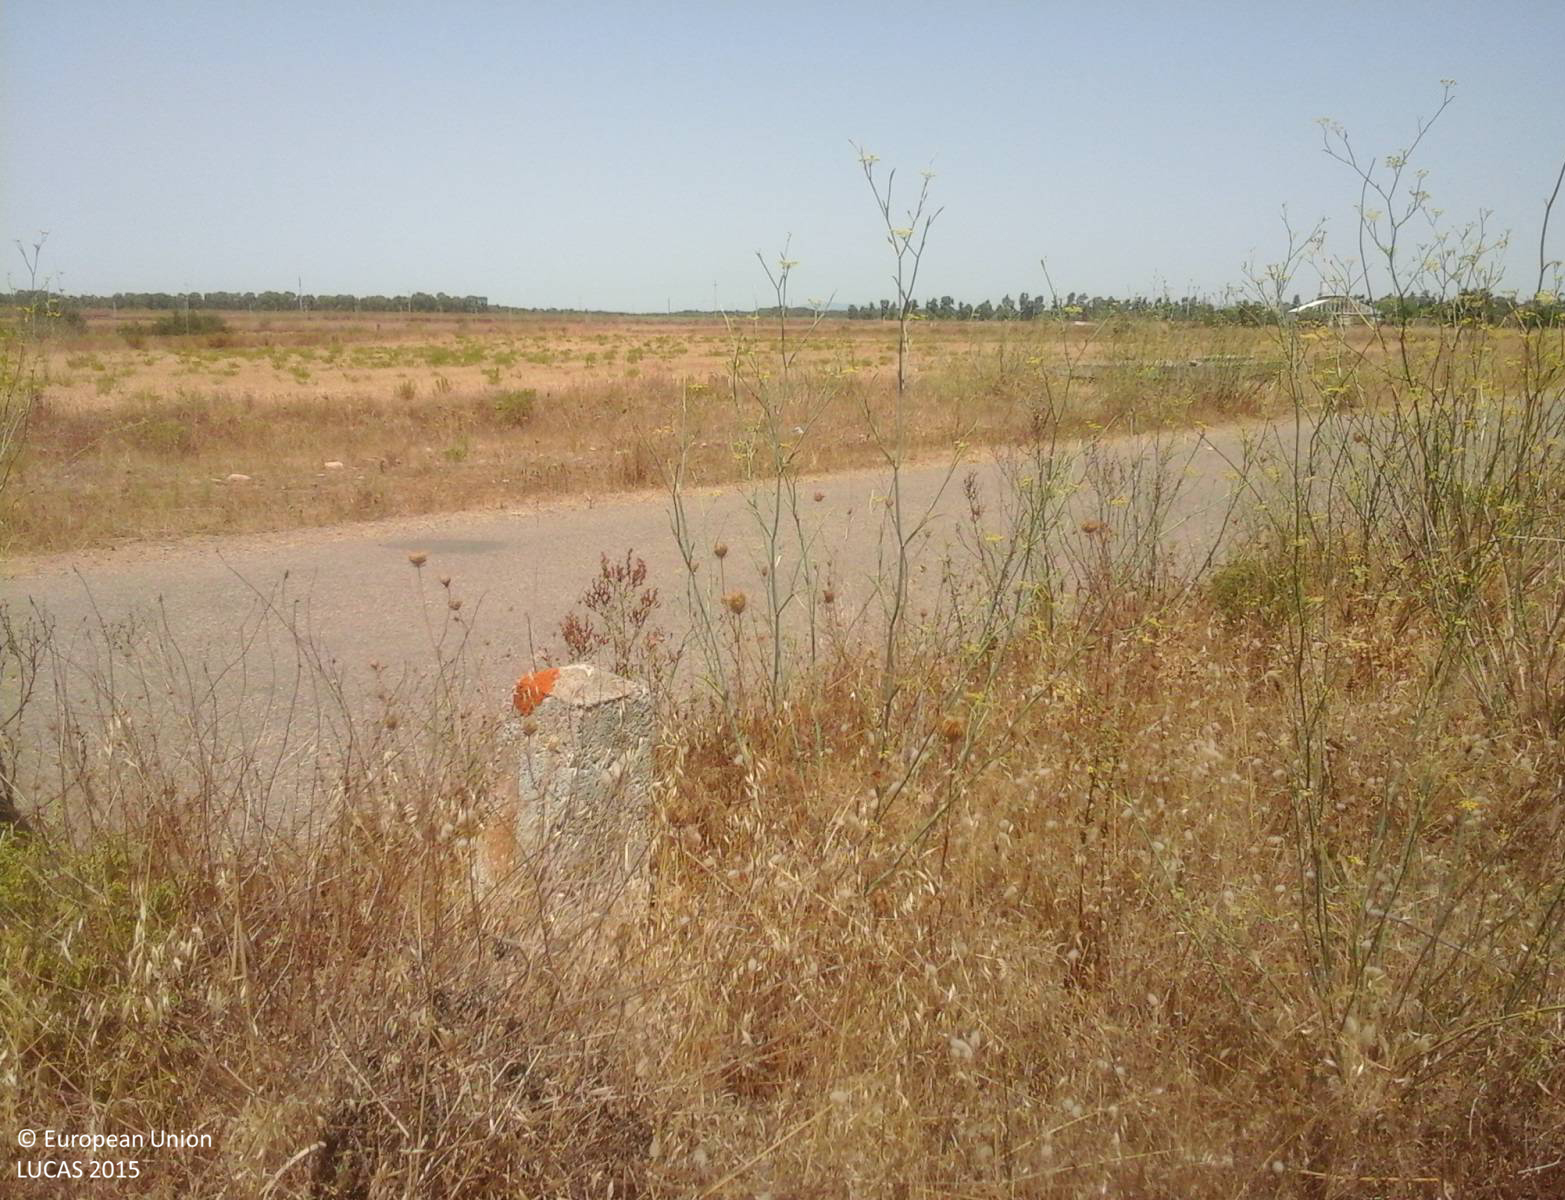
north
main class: Cropland
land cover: Temporary grasslands
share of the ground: > 75 %
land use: Agriculture (excluding fallow land and kitchen gardens)
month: August
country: IT
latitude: 39.4094
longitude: 8.8571
